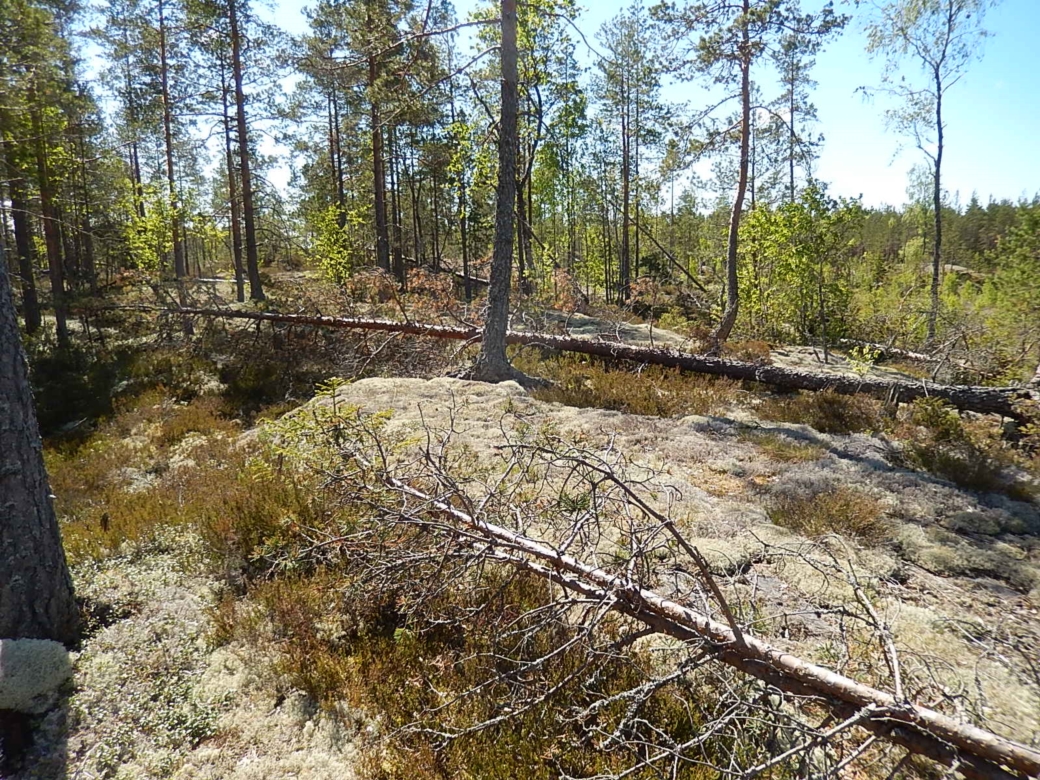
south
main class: Woodland
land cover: Pine dominated coniferous woodland
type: boreal forest
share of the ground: 50 - 75 %
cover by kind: coniferous forest trees 45 %, shrubs 25 %, lichens and mosses 25 %, broadleaved forest trees 5 %
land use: Forestry
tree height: > 5 m
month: June
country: FI
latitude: 62.0544
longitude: 21.5816
